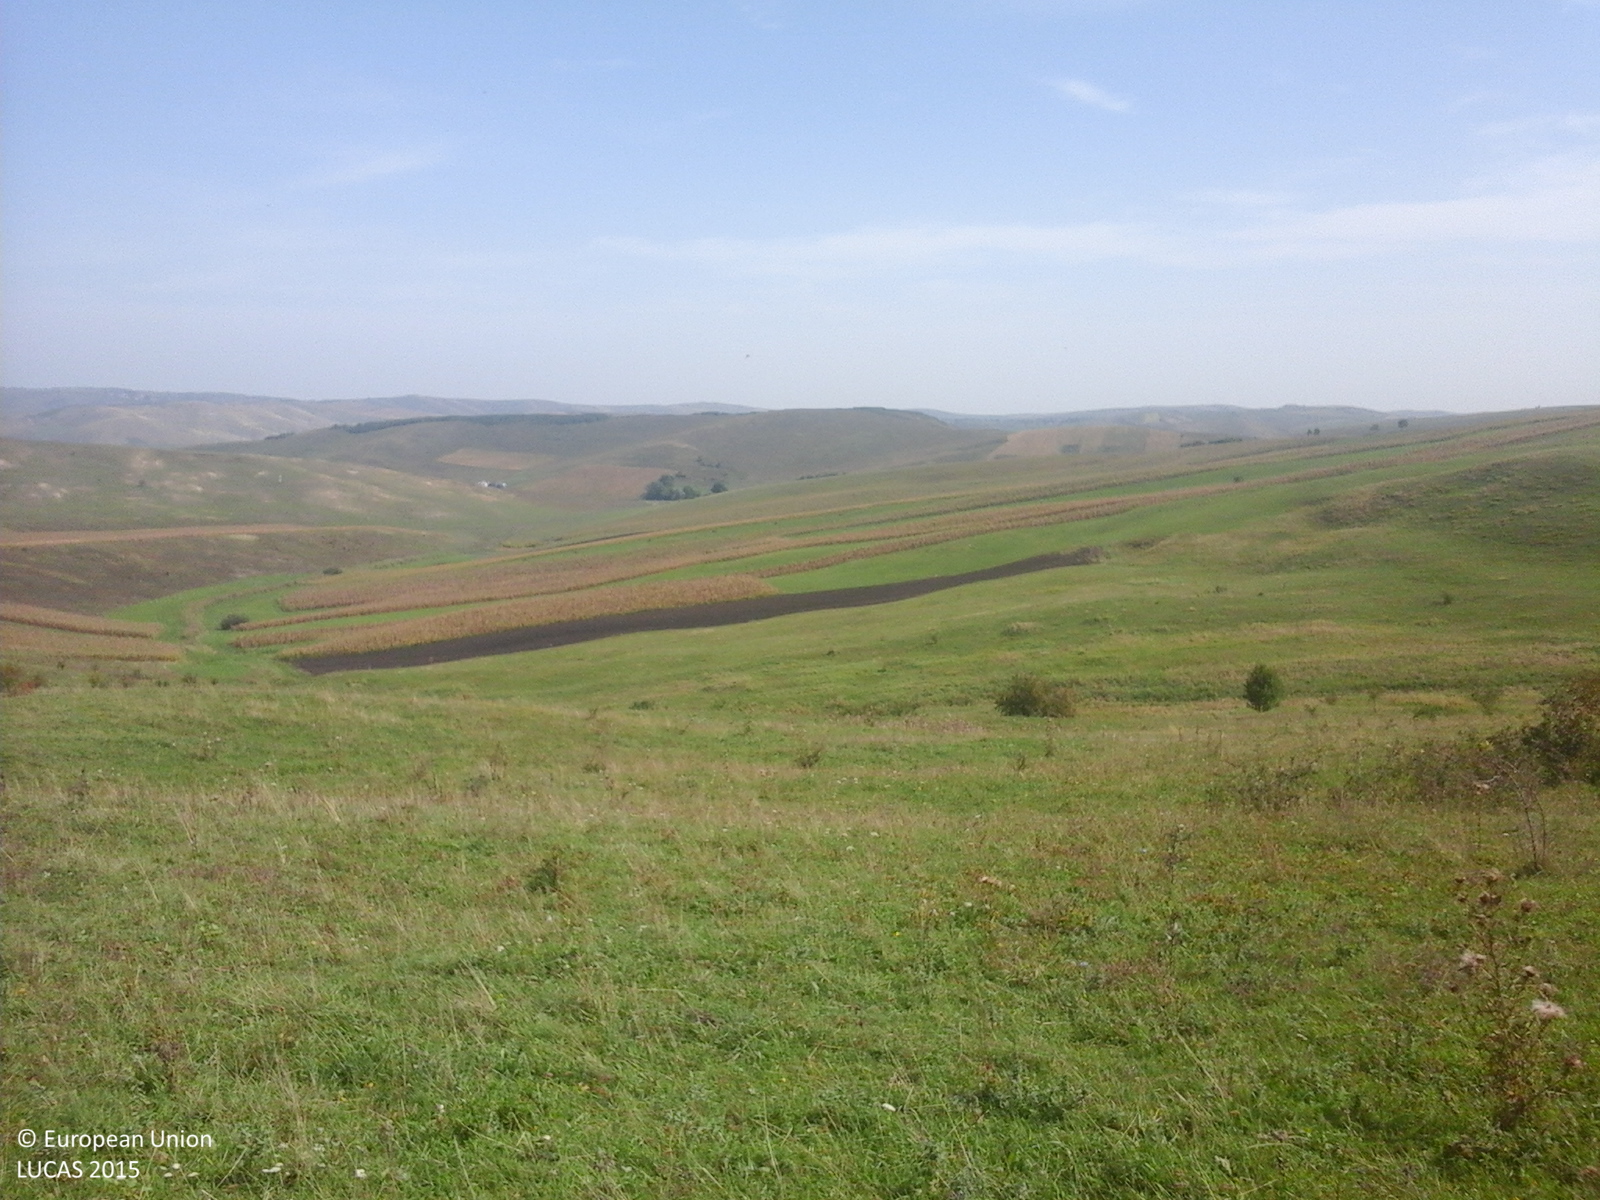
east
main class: Grassland
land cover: Grassland without tree/shrub cover
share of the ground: > 75 %
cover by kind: herbaceous plants 100 %
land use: Agriculture (excluding fallow land and kitchen gardens)
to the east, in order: Grassland without tree/shrub cover; Tracks; Grassland without tree/shrub cover; Tracks; Inland marshes; Grassland without tree/shrub cover; Ditches and canals; Abandoned hedges; Grassland without tree/shrub cover
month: September
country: RO
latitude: 46.7053
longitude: 23.8481
